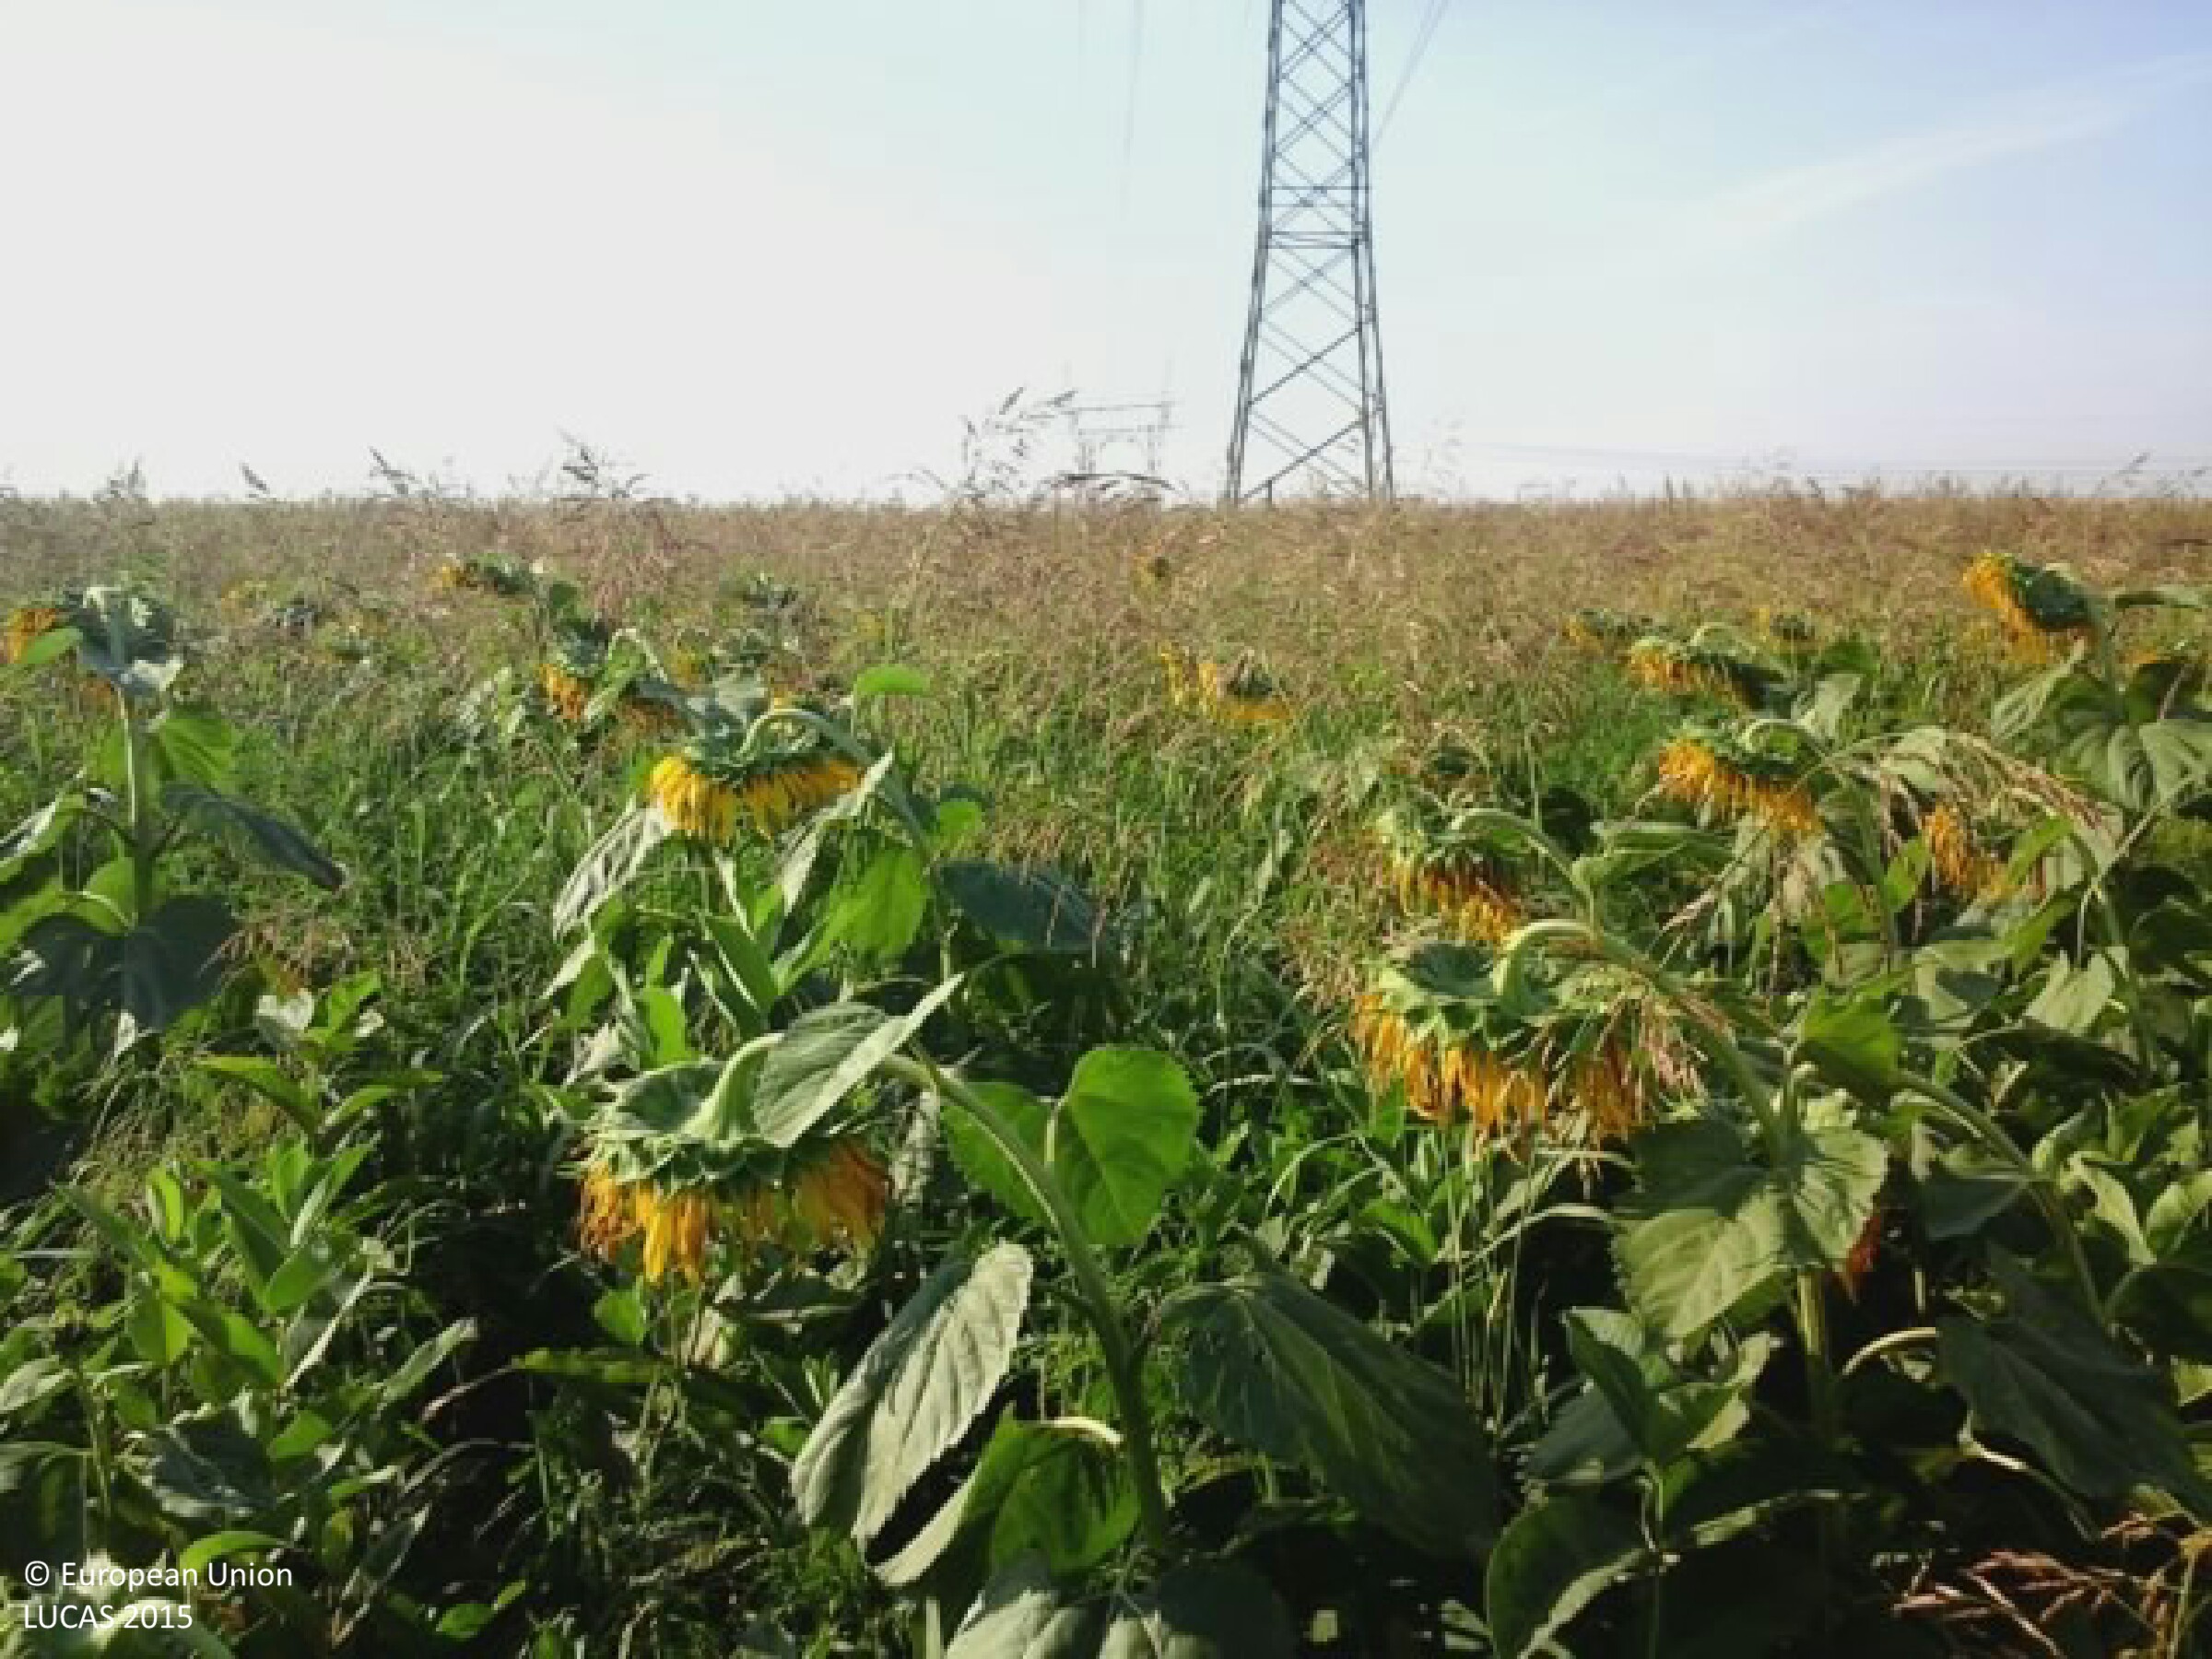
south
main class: Cropland
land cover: Sunflower
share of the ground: > 75 %
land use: Agriculture (excluding fallow land and kitchen gardens)
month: August
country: HU
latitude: 47.3051
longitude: 19.0774
